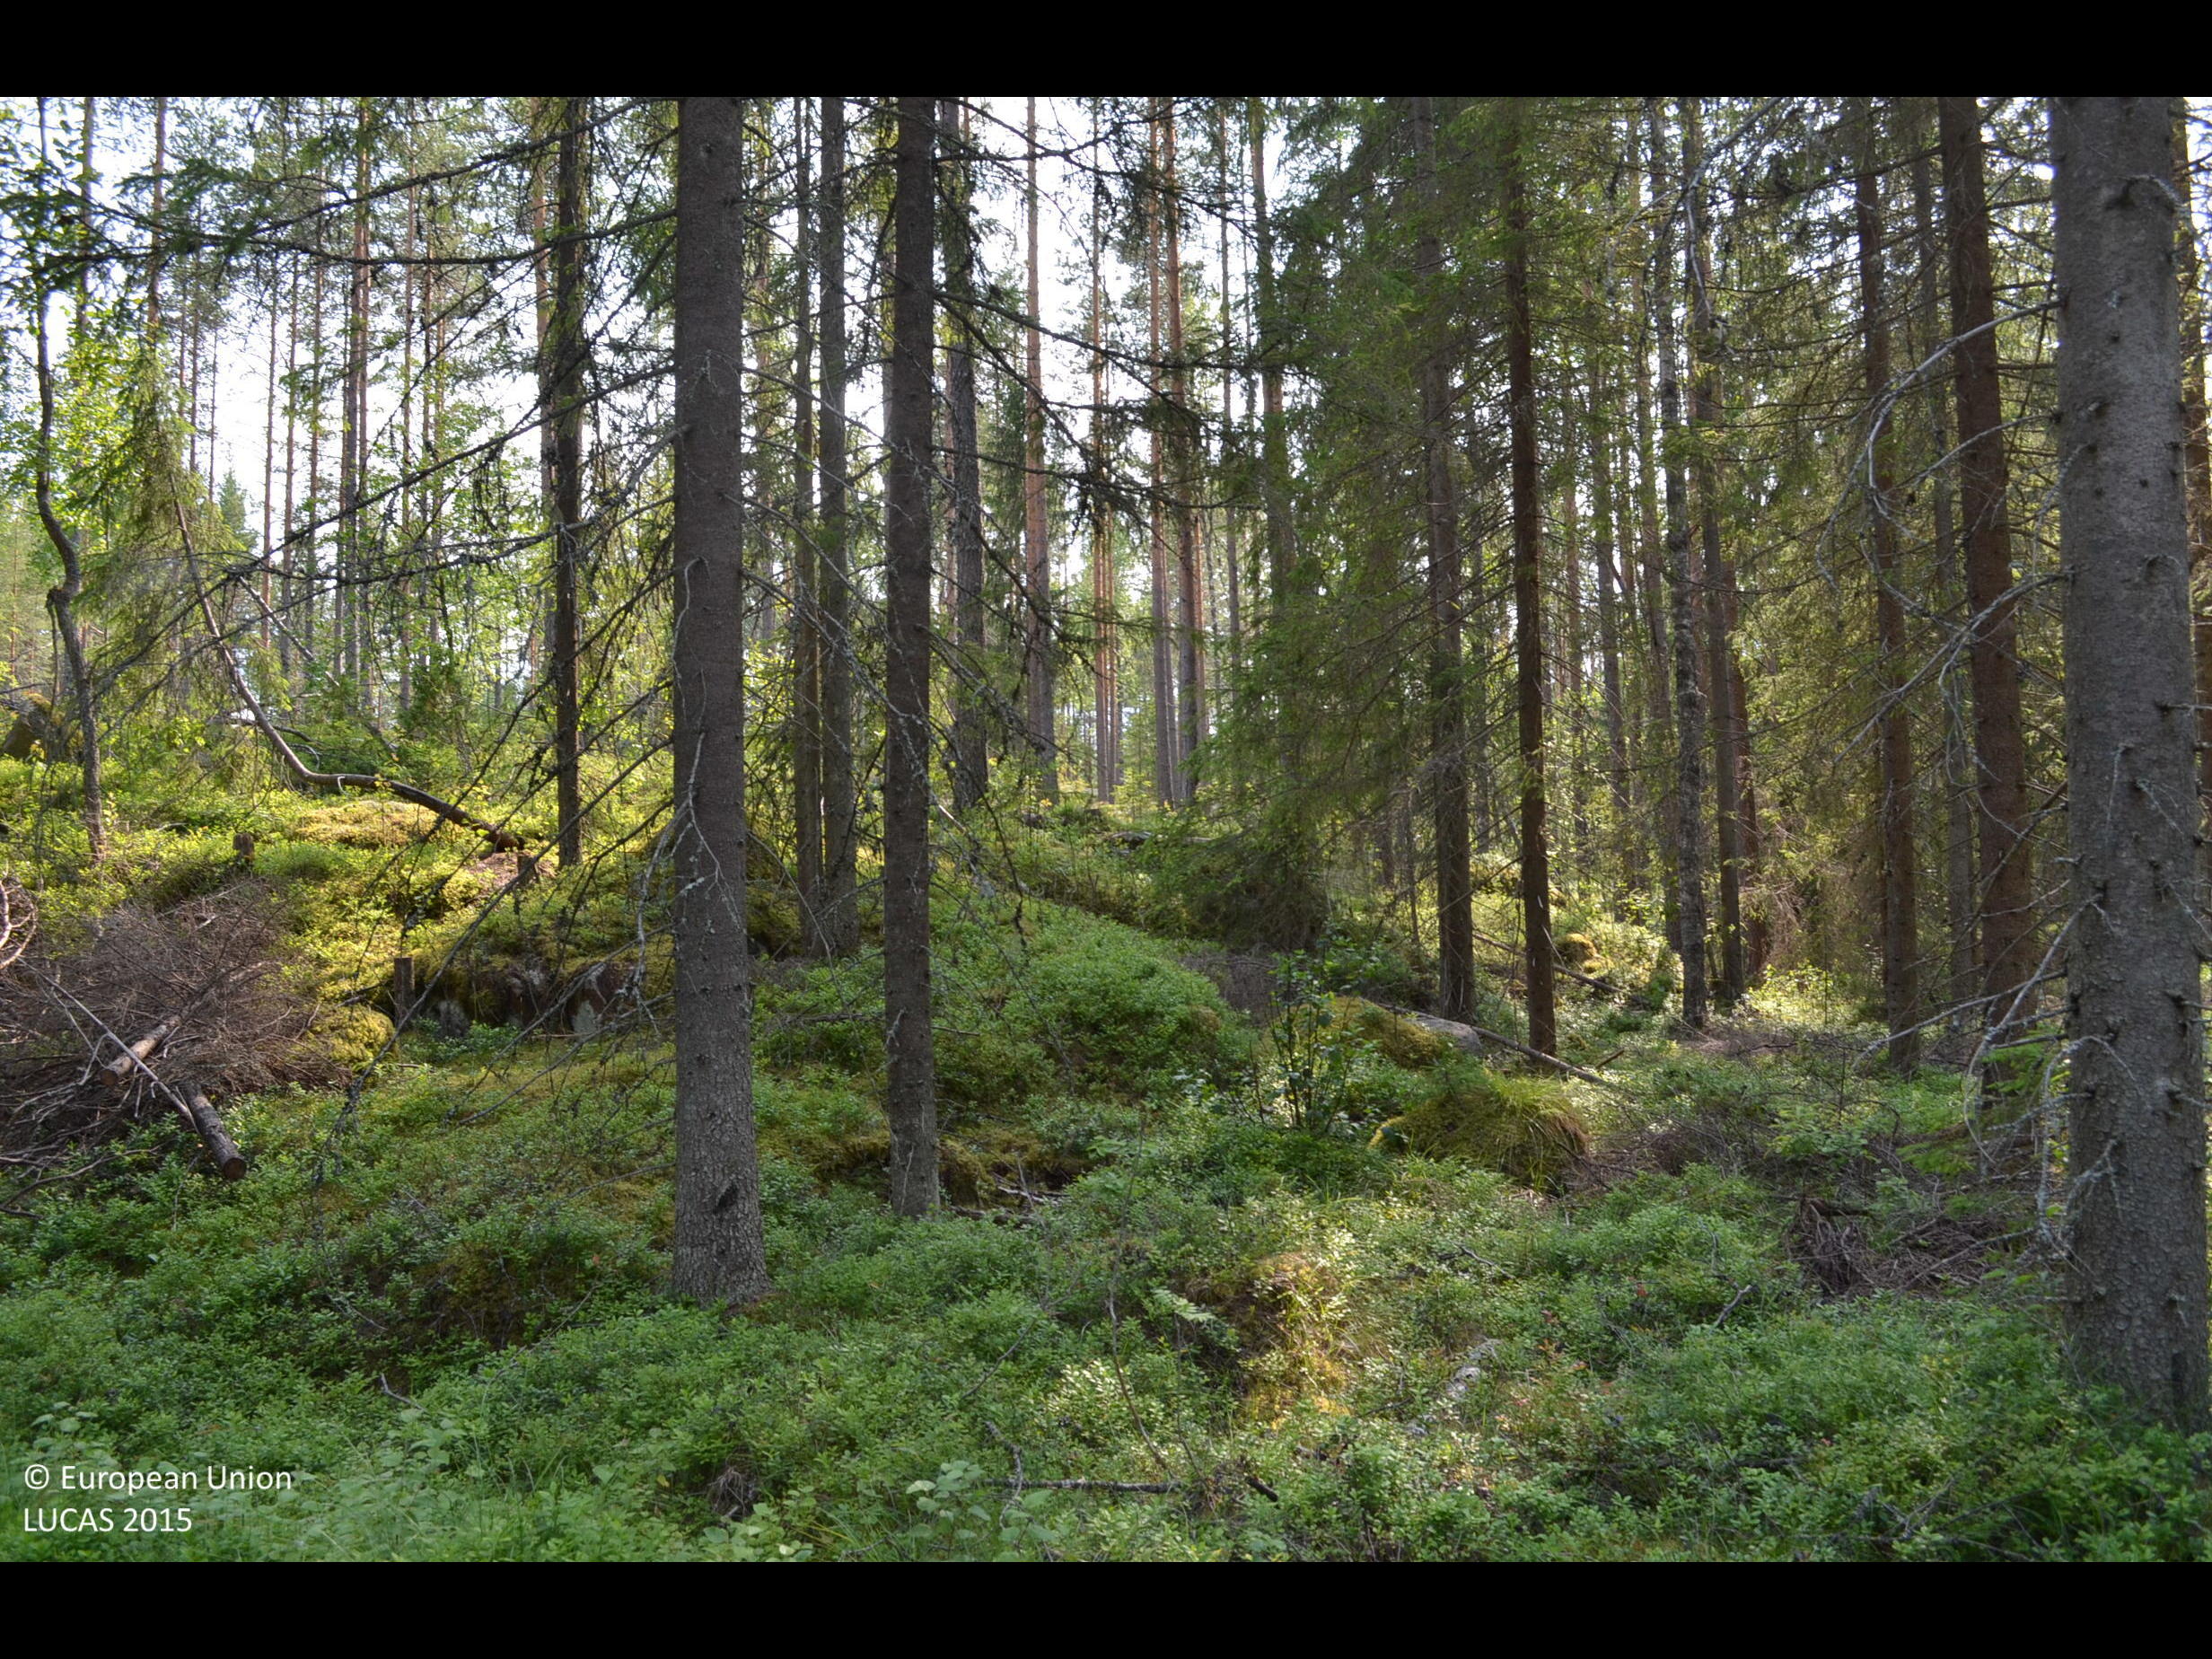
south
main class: Woodland
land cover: Other coniferous woodland
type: boreal forest
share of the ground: 50 - 75 %
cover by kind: coniferous forest trees 60 %, shrubs 30 %, broadleaved forest trees 5 %, herbaceous plants 5 %
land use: Forestry
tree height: > 5 m
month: July
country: FI
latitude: 62.2193
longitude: 23.5170
